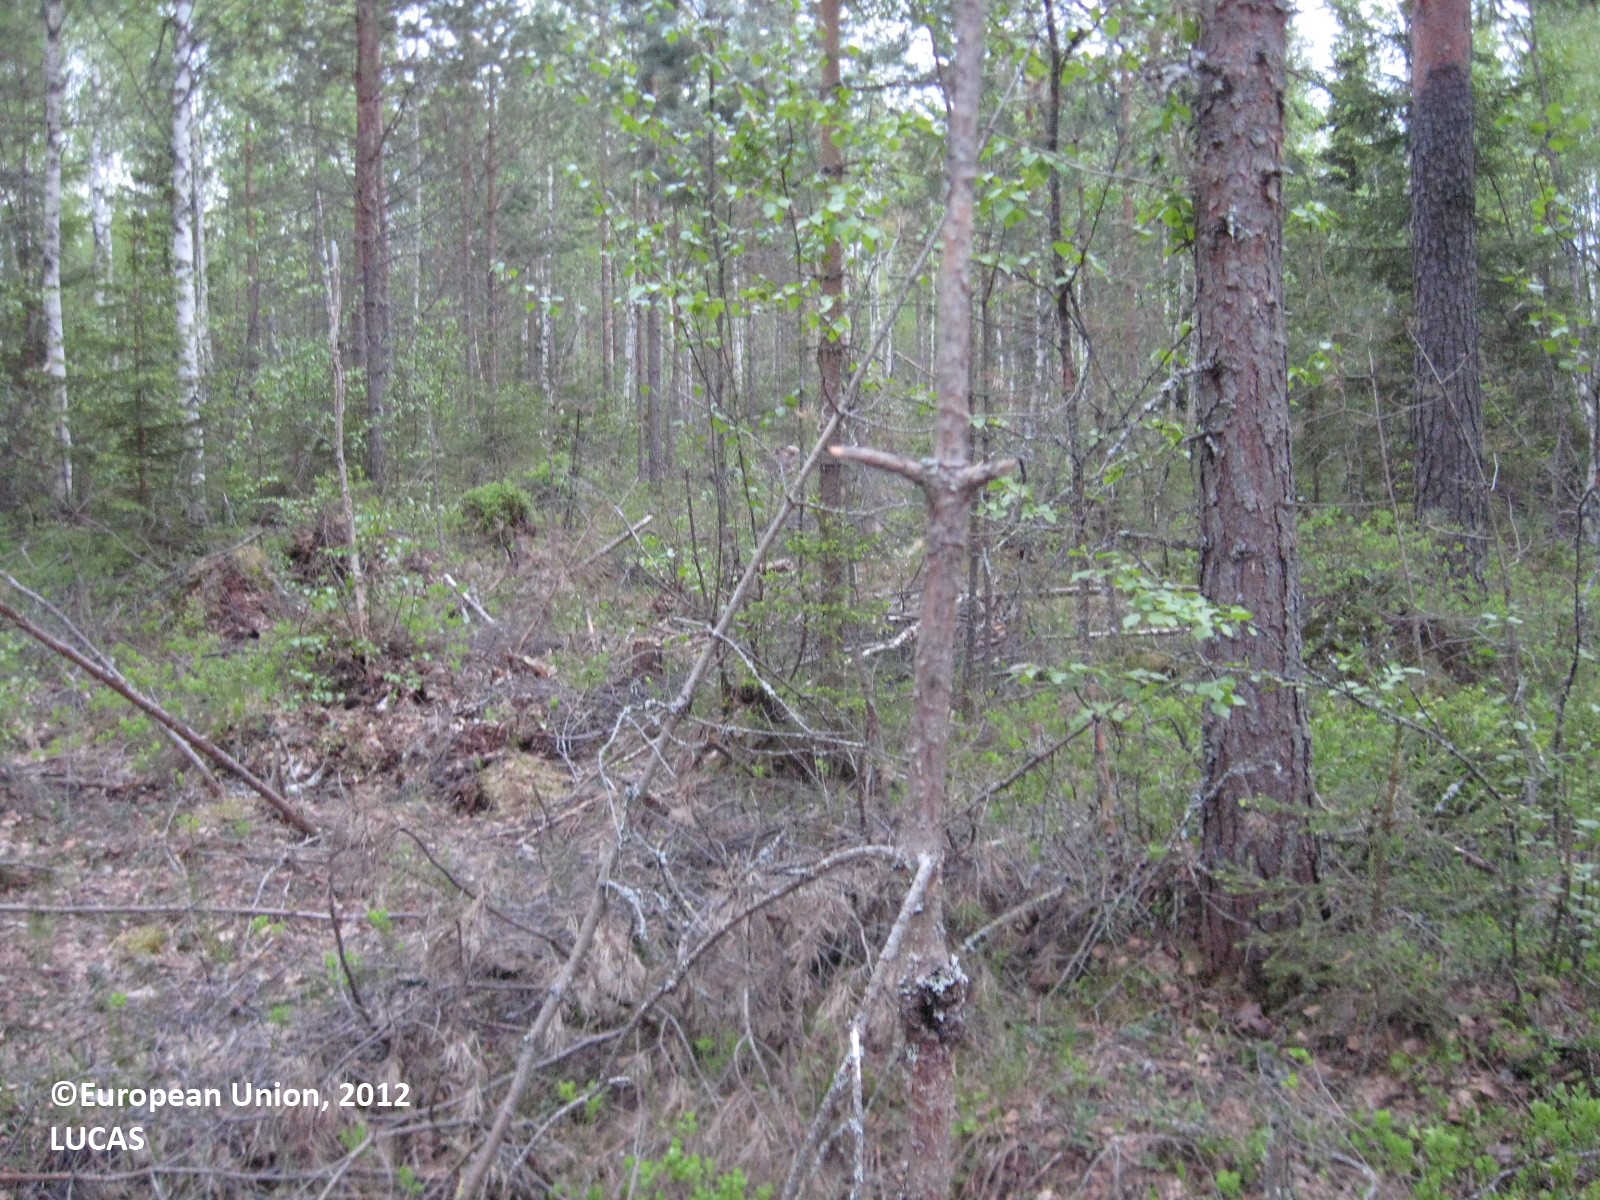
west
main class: Woodland
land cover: Pine dominated mixed woodland
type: boreal forest
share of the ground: 50 - 75 %
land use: Forestry
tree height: > 5 m
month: May
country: FI
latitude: 61.7728
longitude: 22.1293
